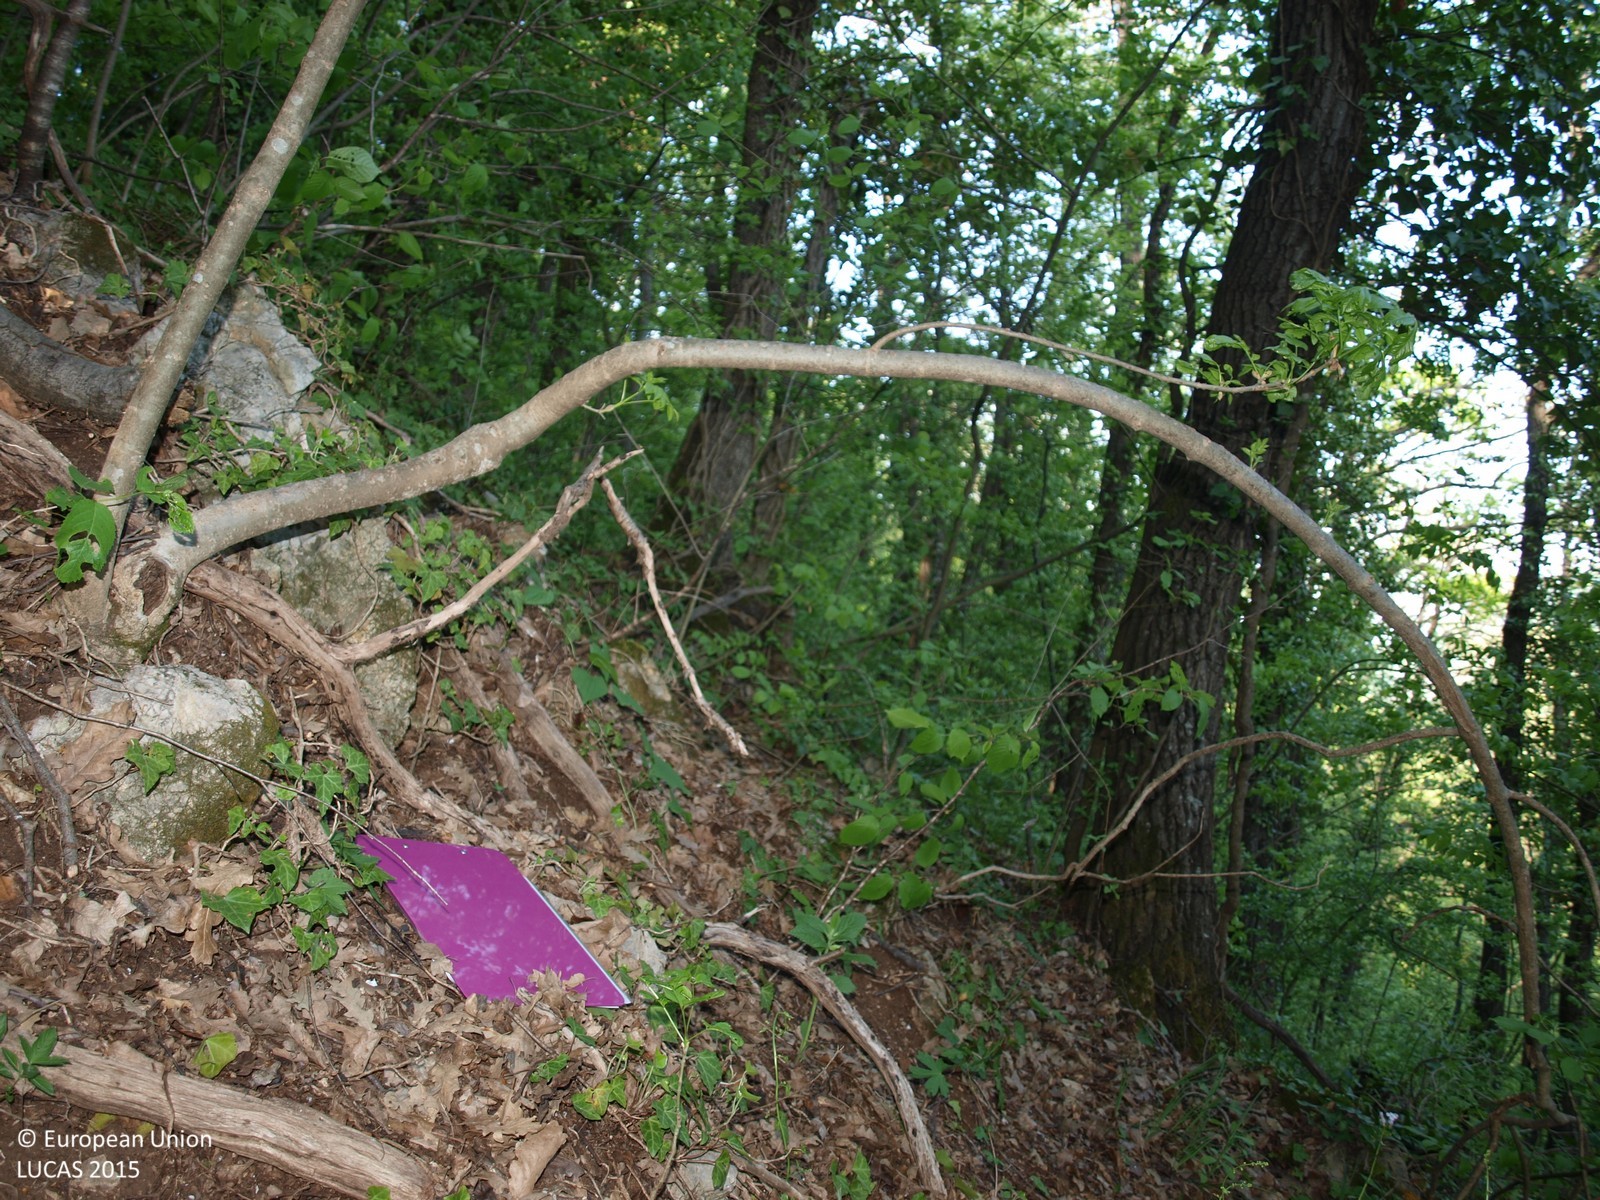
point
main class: Woodland
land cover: Broadleaved woodland
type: mesophytic deciduous forest
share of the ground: > 75 %
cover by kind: broadleaved forest trees 90 %, shrubs 5 %, herbaceous plants 5 %
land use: Forestry
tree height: > 5 m
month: April
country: HR
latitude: 46.2009
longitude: 15.9992
